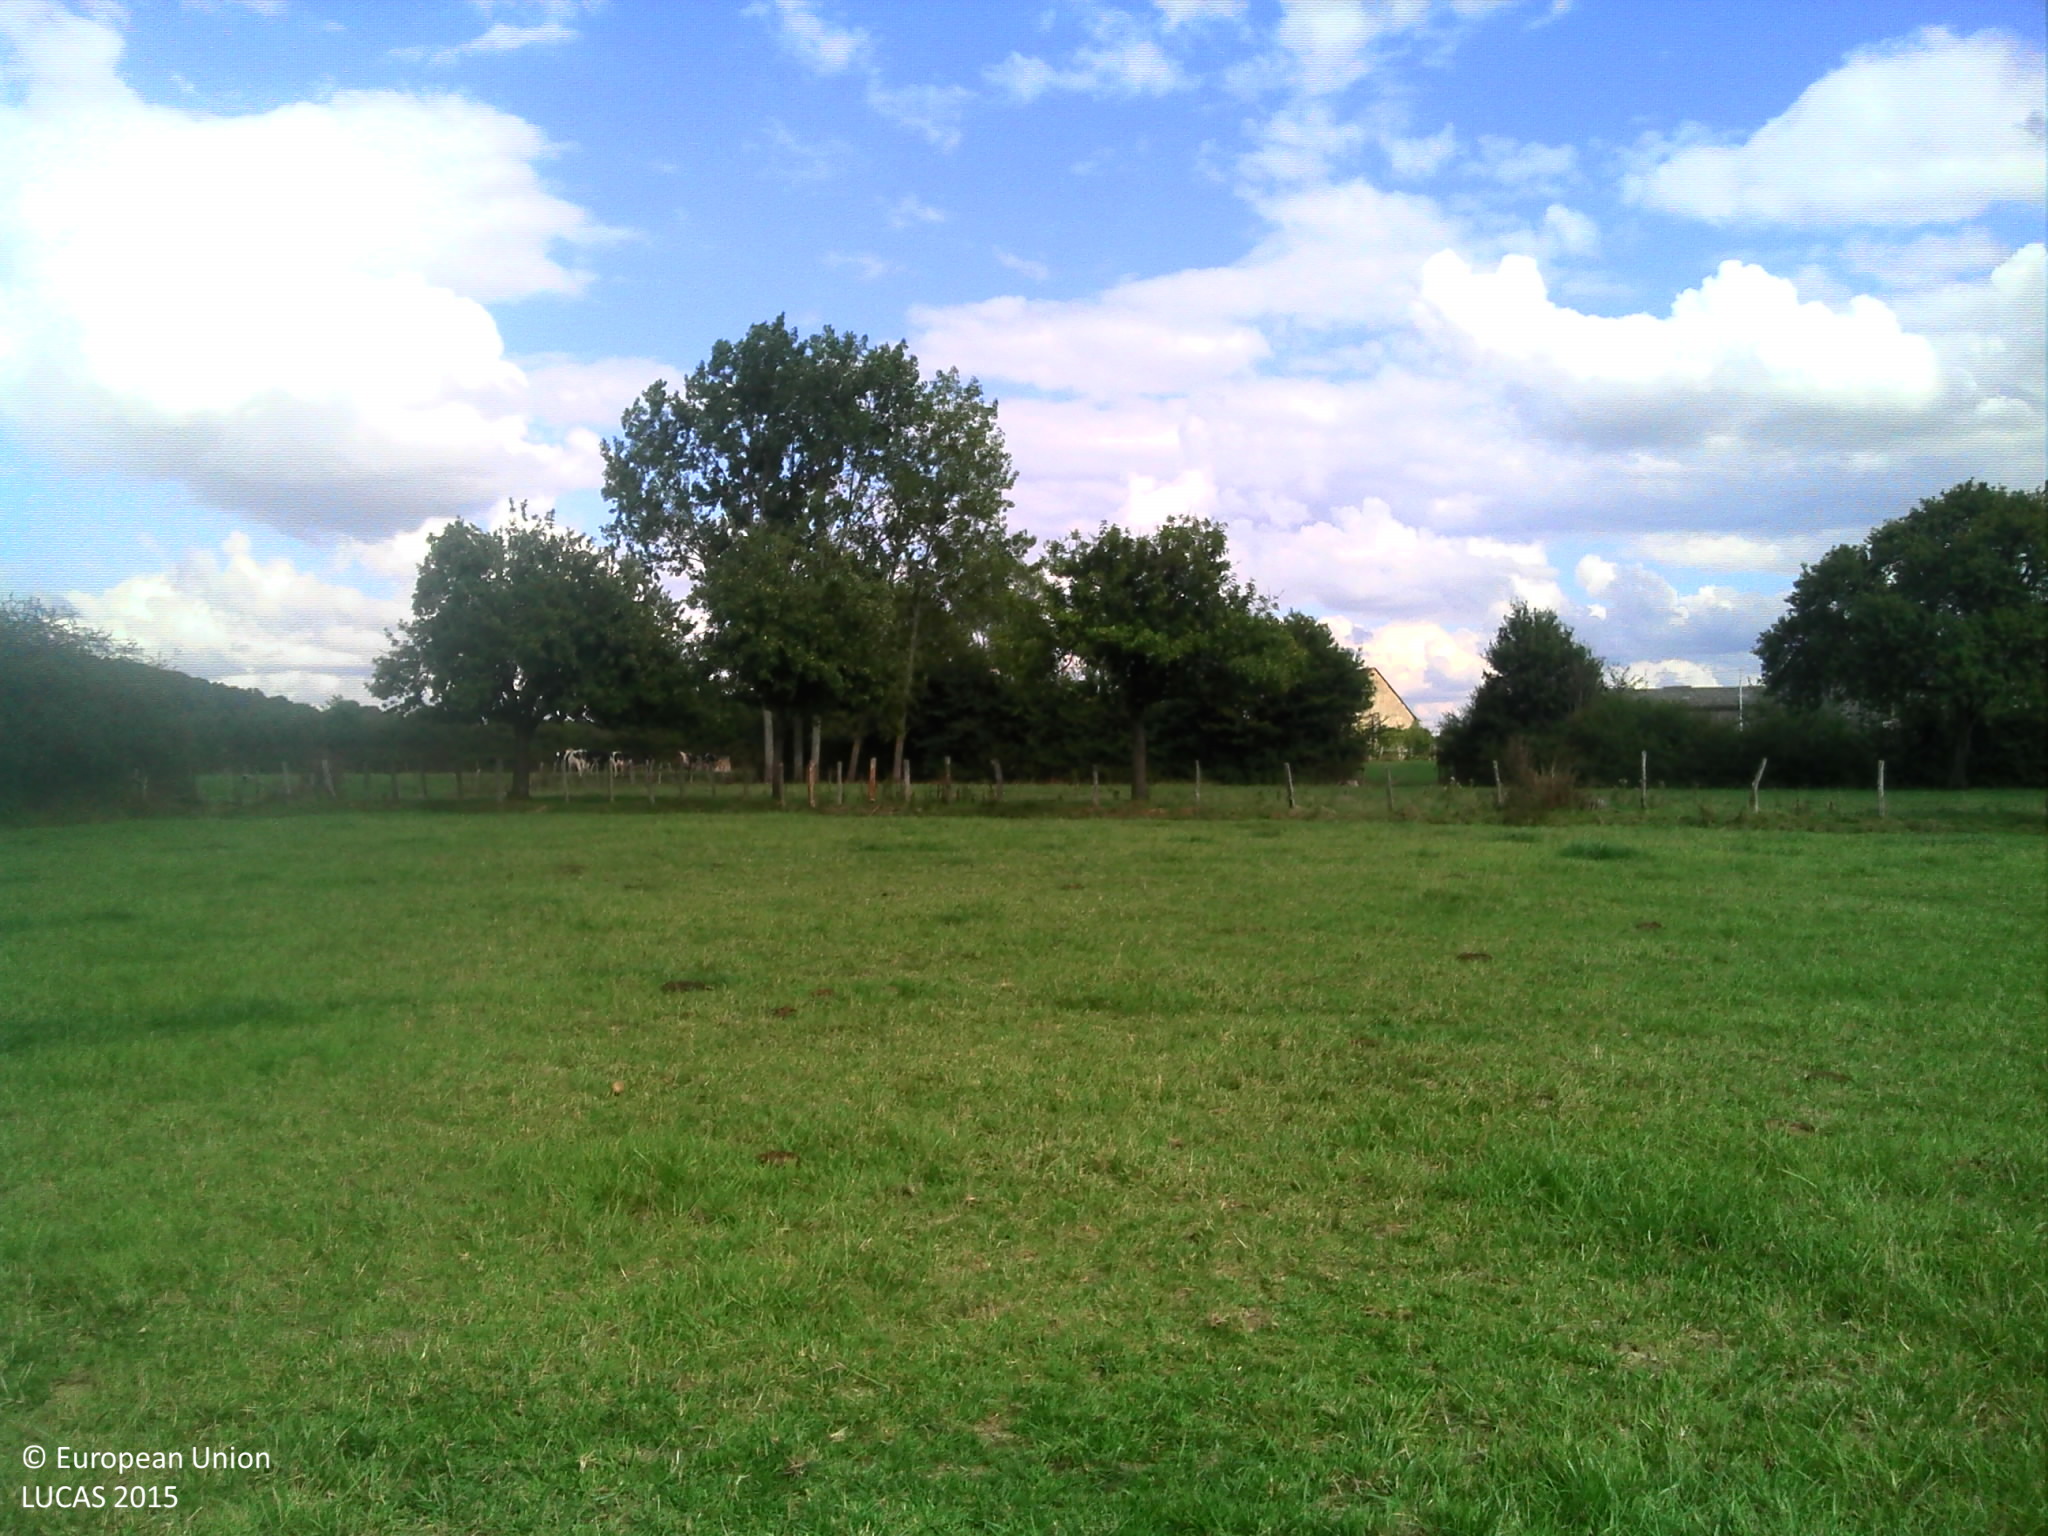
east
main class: Grassland
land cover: Grassland without tree/shrub cover
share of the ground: > 75 %
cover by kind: herbaceous plants 100 %
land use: Agriculture (excluding fallow land and kitchen gardens)
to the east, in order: Grassland without tree/shrub cover; Fences; Grassland with sparse tree/shrub cover; Grassland without tree/shrub cover; Managed hedges; Fences; Grassland without tree/shrub cover; Artificial constructions in urban areas; Grassland without tree/shrub cover
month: September
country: FR
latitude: 48.2905
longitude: 0.5821
